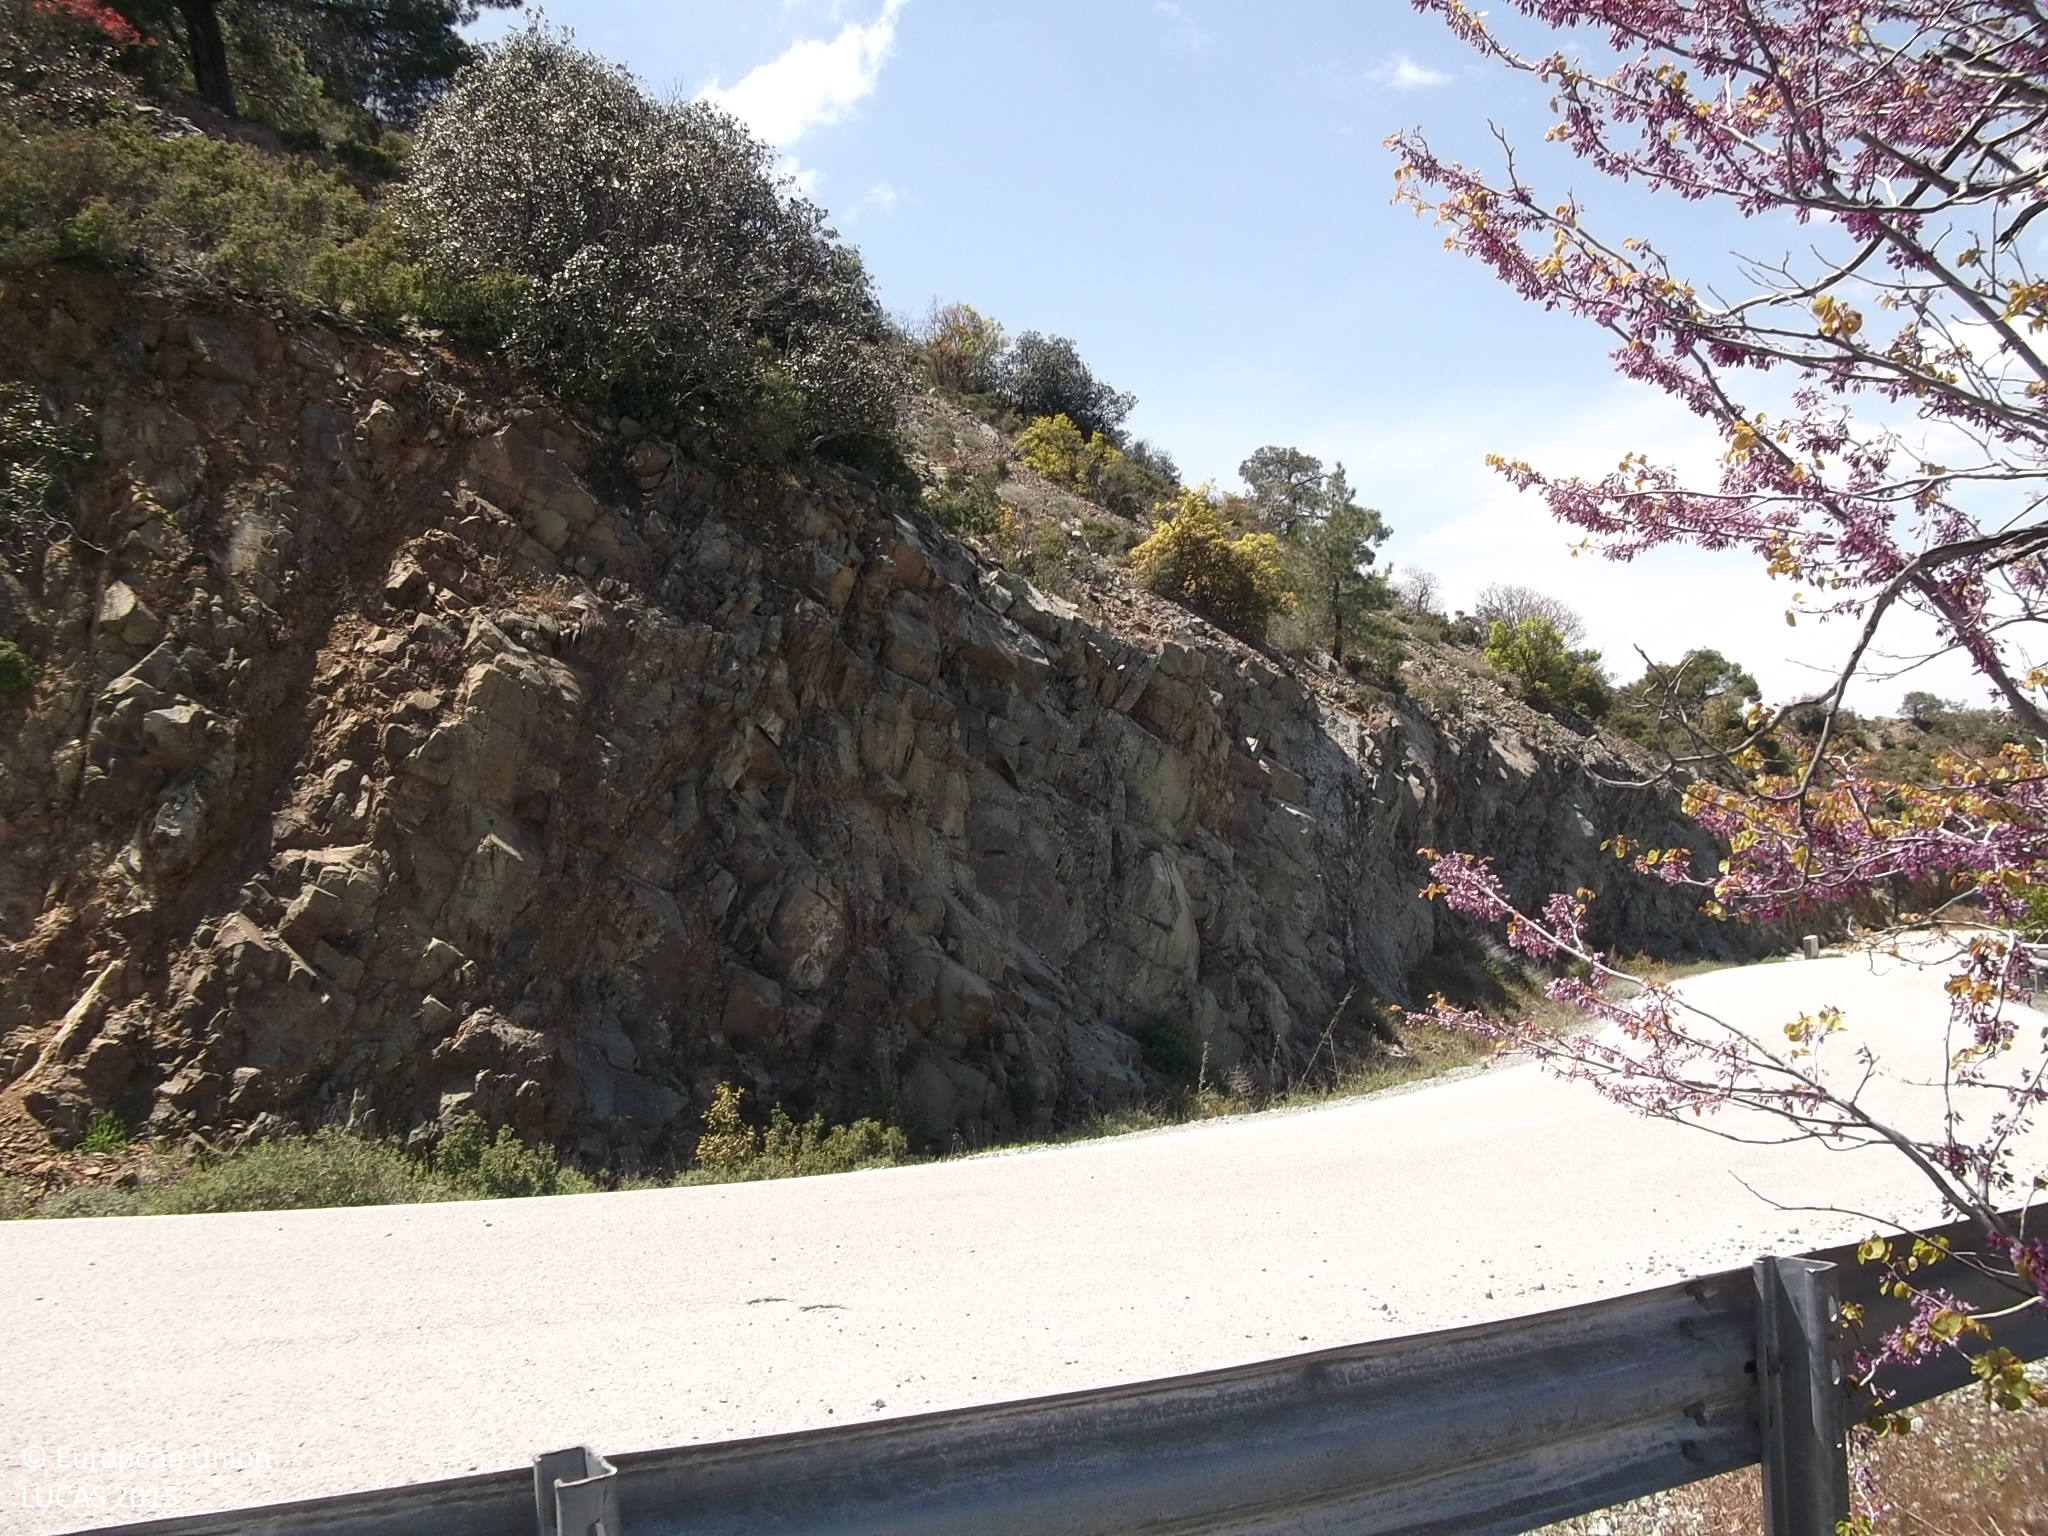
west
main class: Woodland
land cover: Pine dominated mixed woodland
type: coniferous forest of the mediterranean region
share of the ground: > 75 %
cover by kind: coniferous forest trees 60 %, broadleaved forest trees 20 %, unconsolidated bare surface 20 %
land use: Semi-natural and natural areas not in use
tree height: > 5 m
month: April
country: CY
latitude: 34.9297
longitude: 33.2019
